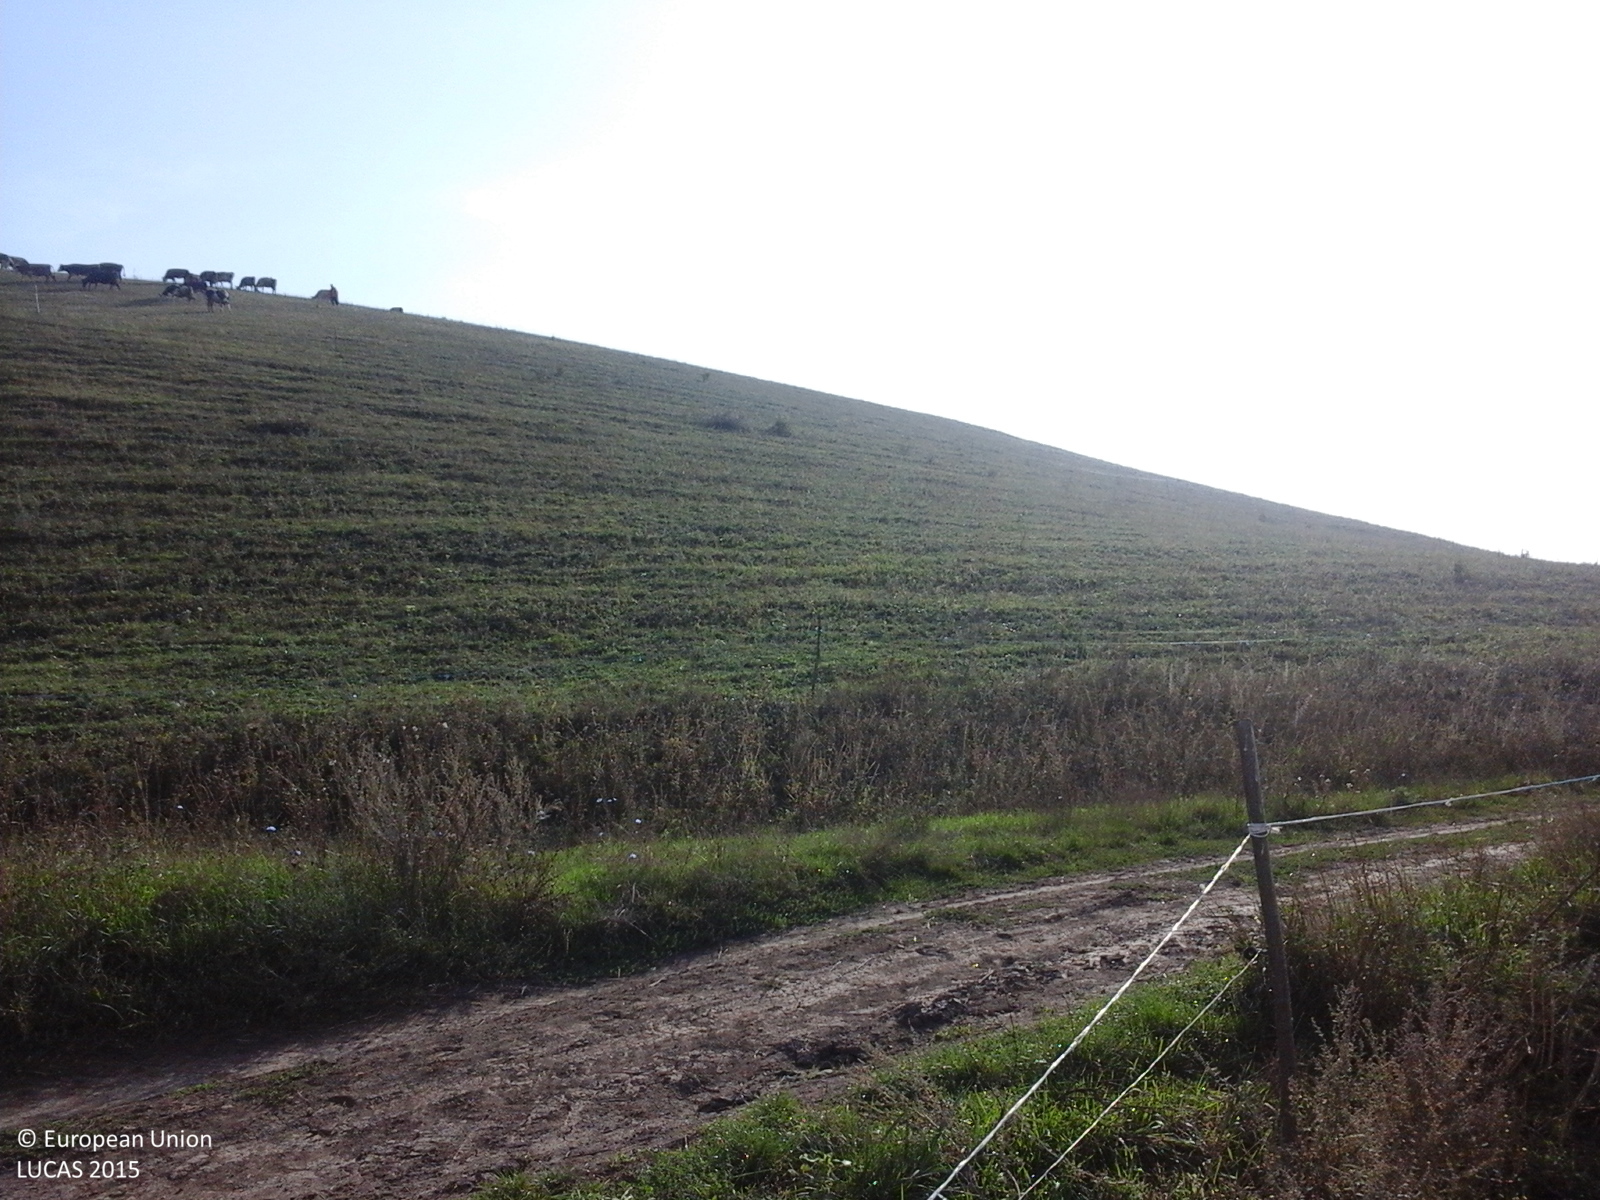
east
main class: Grassland
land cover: Grassland without tree/shrub cover
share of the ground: > 75 %
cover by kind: herbaceous plants 100 %
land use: Agriculture (excluding fallow land and kitchen gardens)
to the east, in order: Grassland without tree/shrub cover; Tracks; Grassland without tree/shrub cover
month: September
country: RO
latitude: 46.6523
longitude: 23.8340
